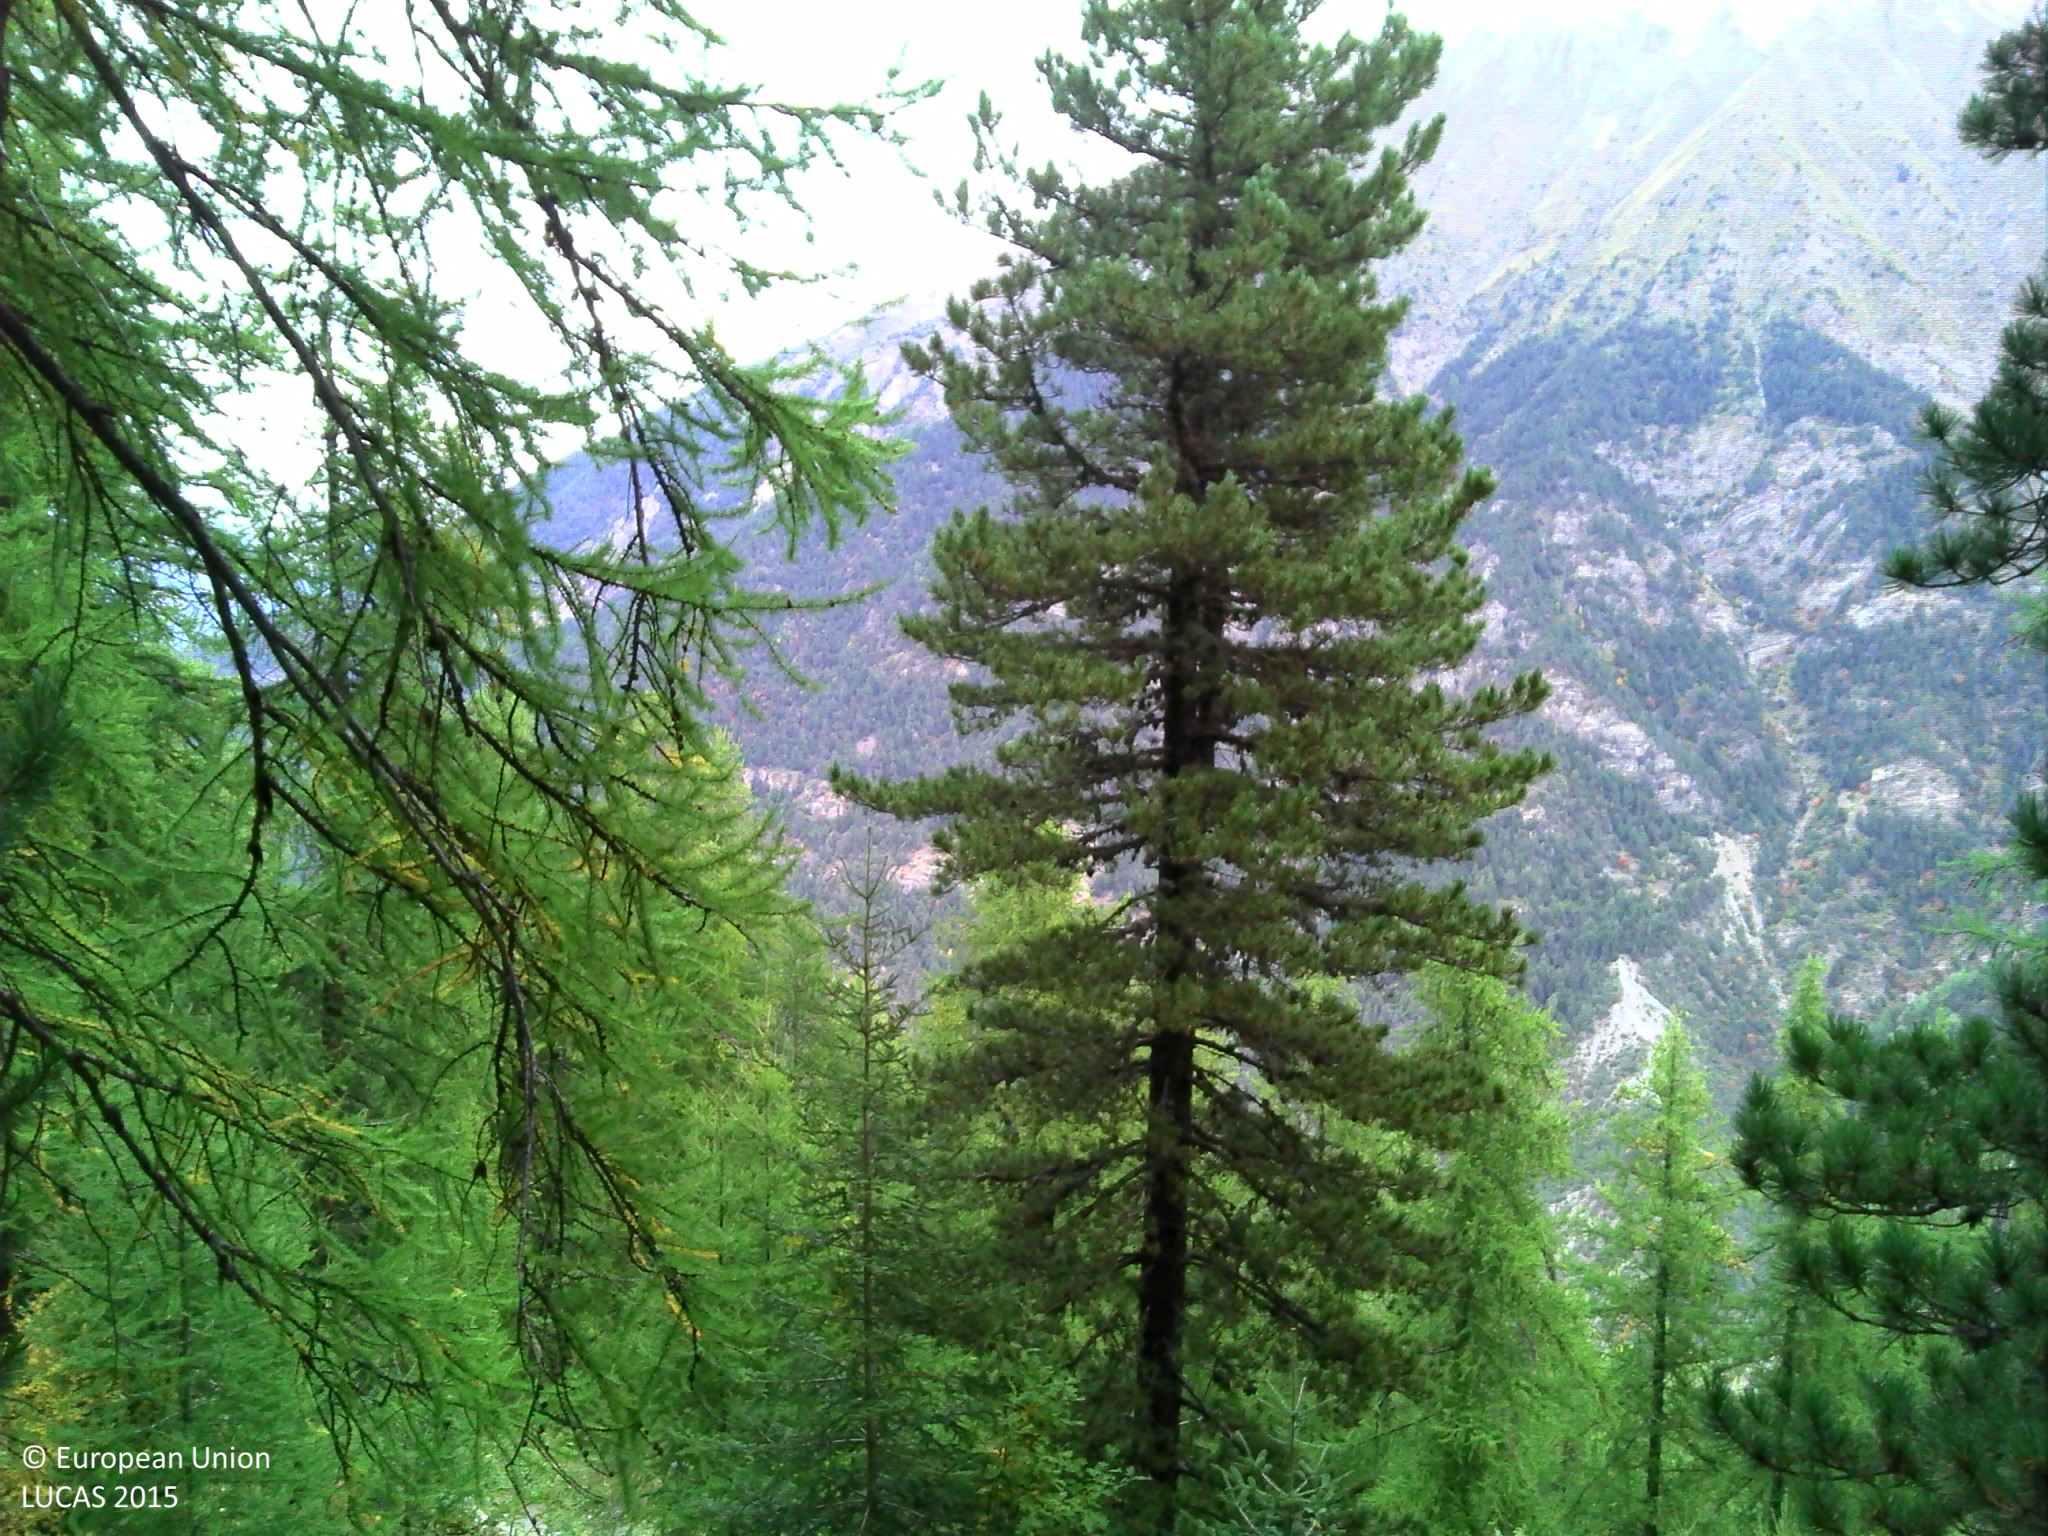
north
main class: Woodland
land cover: Other coniferous woodland
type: alpine coniferous forest
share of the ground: 50 - 75 %
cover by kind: coniferous forest trees 50 %, herbaceous plants 35 %, broadleaved forest trees 10 %, shrubs 5 %
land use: Forestry
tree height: > 5 m
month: September
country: FR
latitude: 44.5466
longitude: 6.5700
